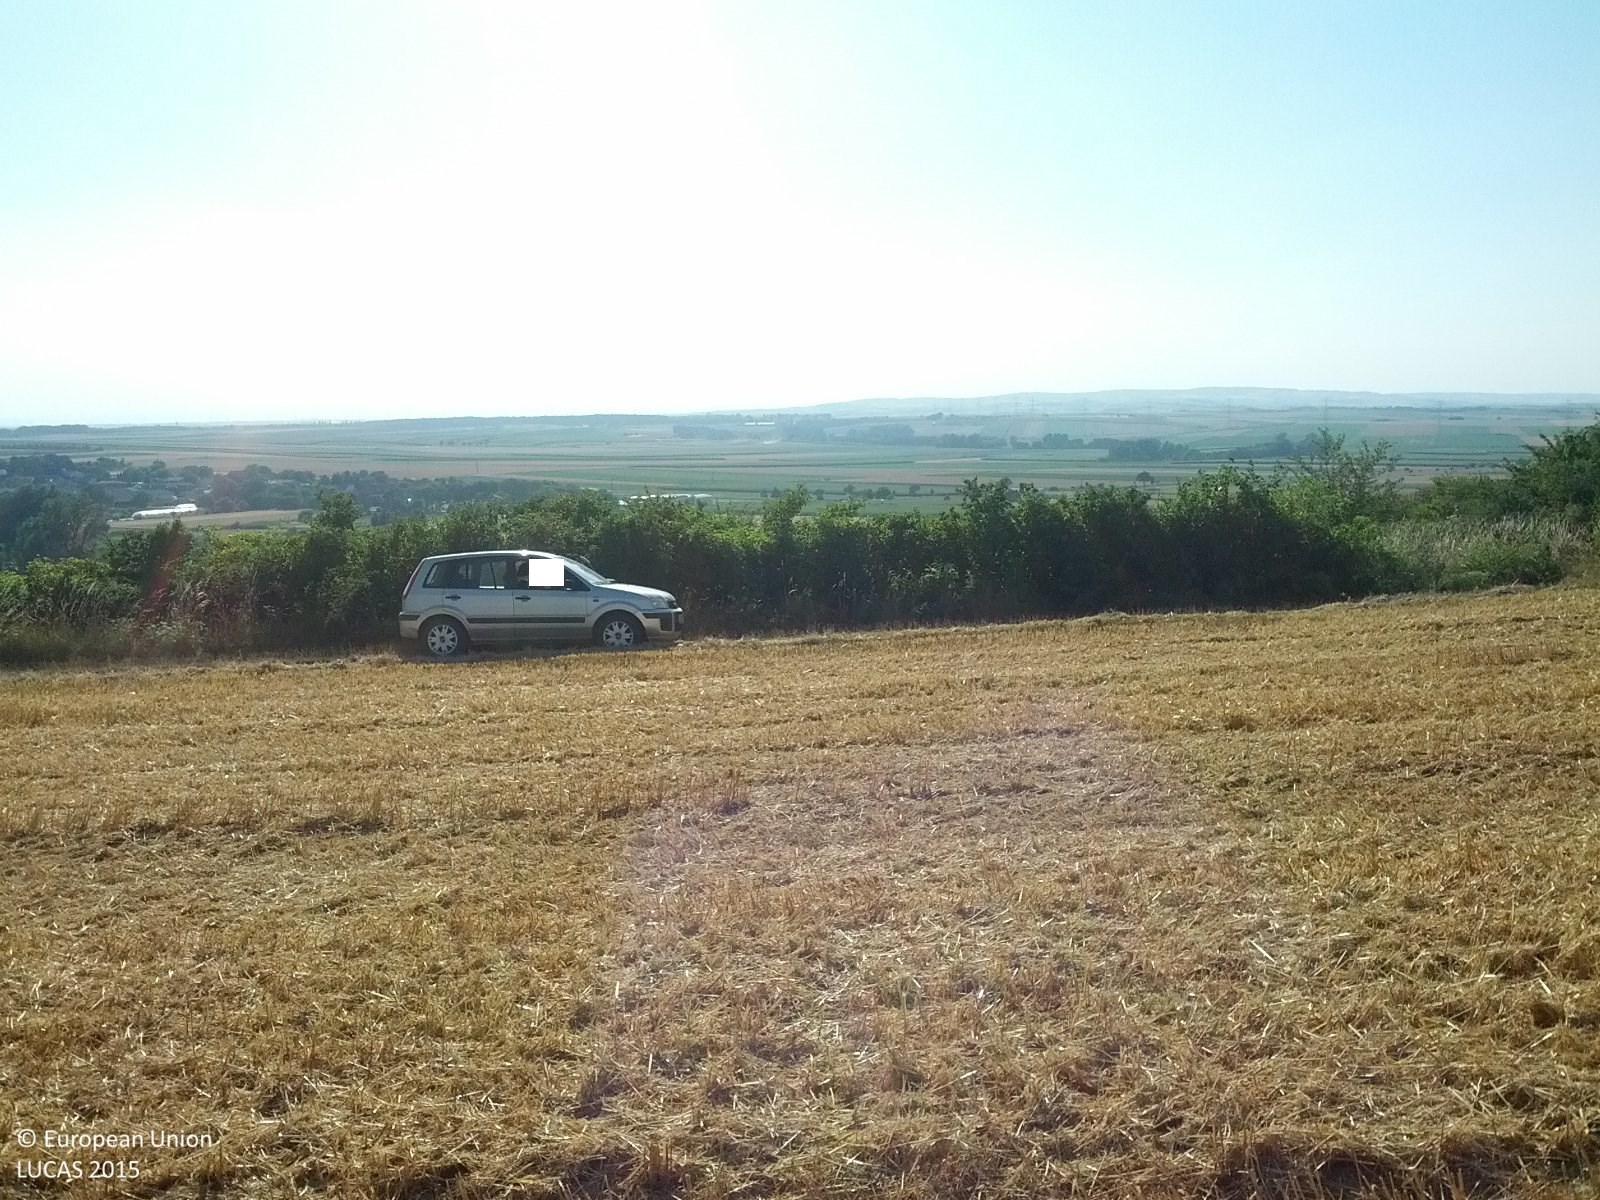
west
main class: Cropland
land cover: Common wheat
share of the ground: 10 - 25 %
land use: Agriculture (excluding fallow land and kitchen gardens)
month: July
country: AT
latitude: 48.4245
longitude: 16.2618
